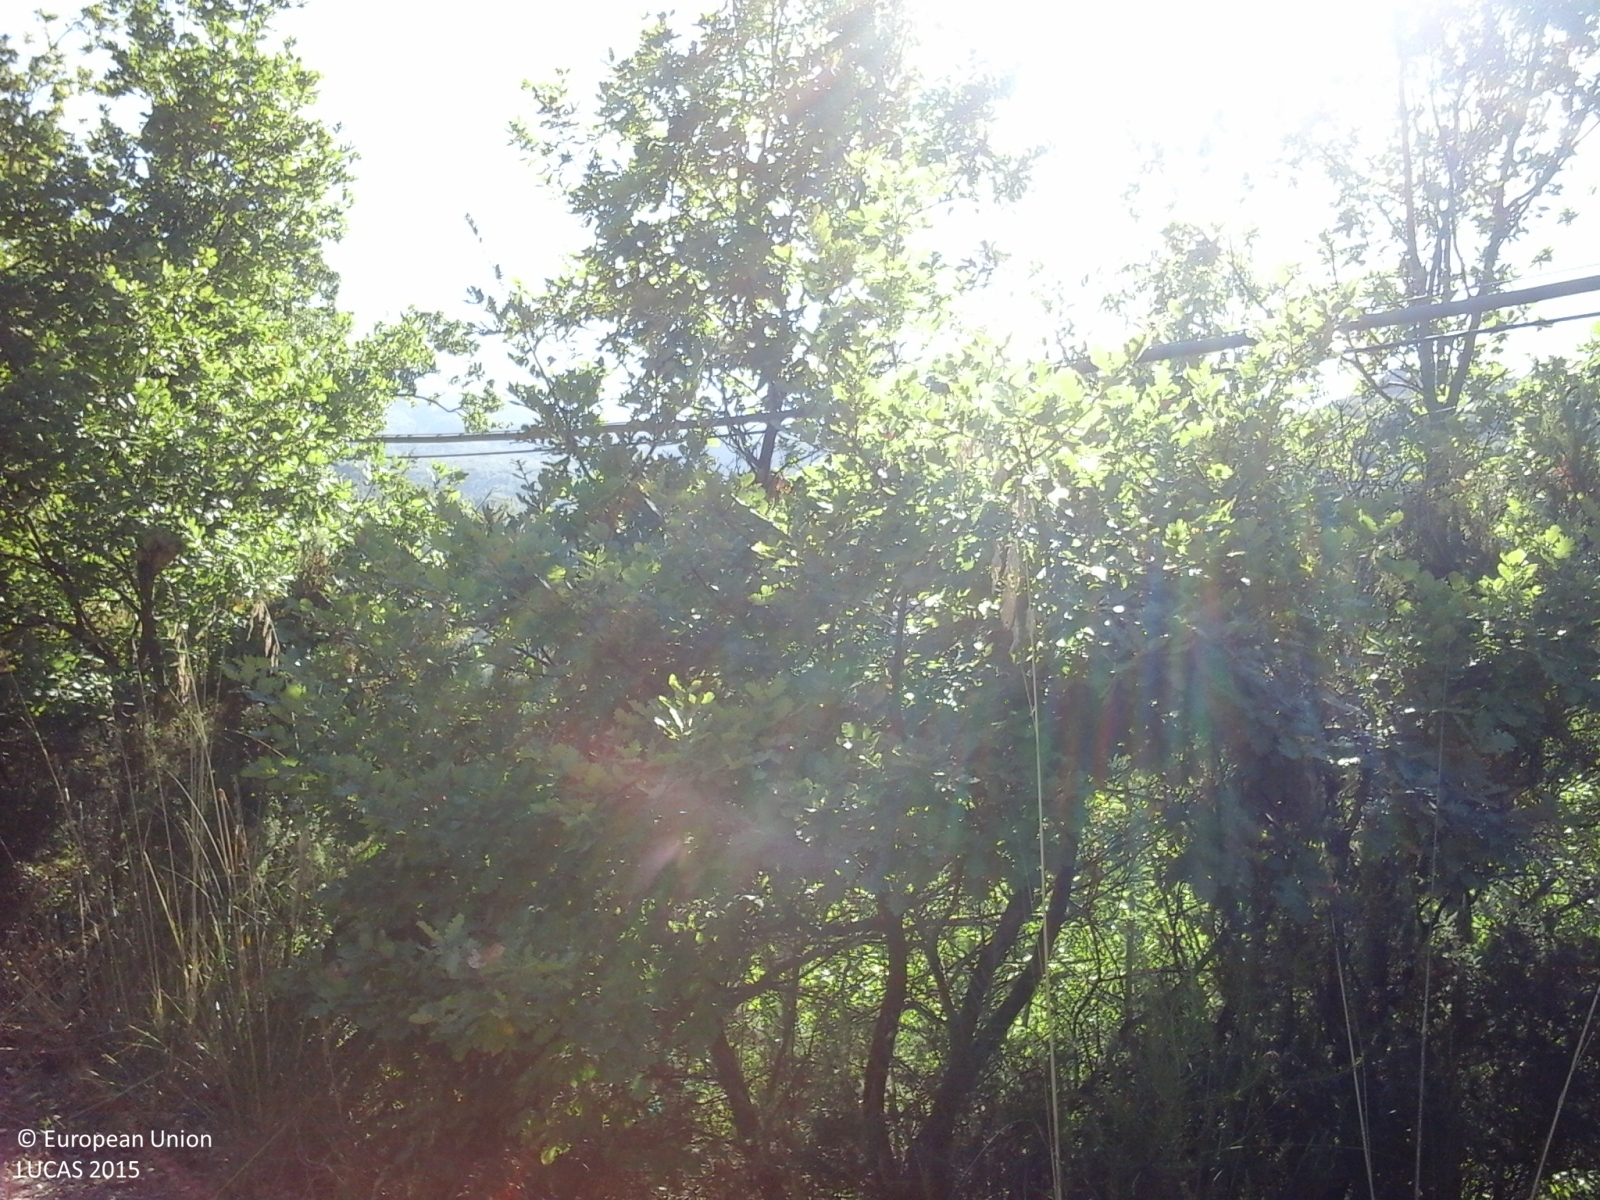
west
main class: Shrubland
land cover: Shrubland with sparse tree cover
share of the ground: > 75 %
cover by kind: shrubs 75 %, herbaceous plants 20 %, broadleaved forest trees 5 %
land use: Abandoned areas
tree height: > 5 m
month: August
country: IT
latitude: 40.2620
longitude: 15.0923
